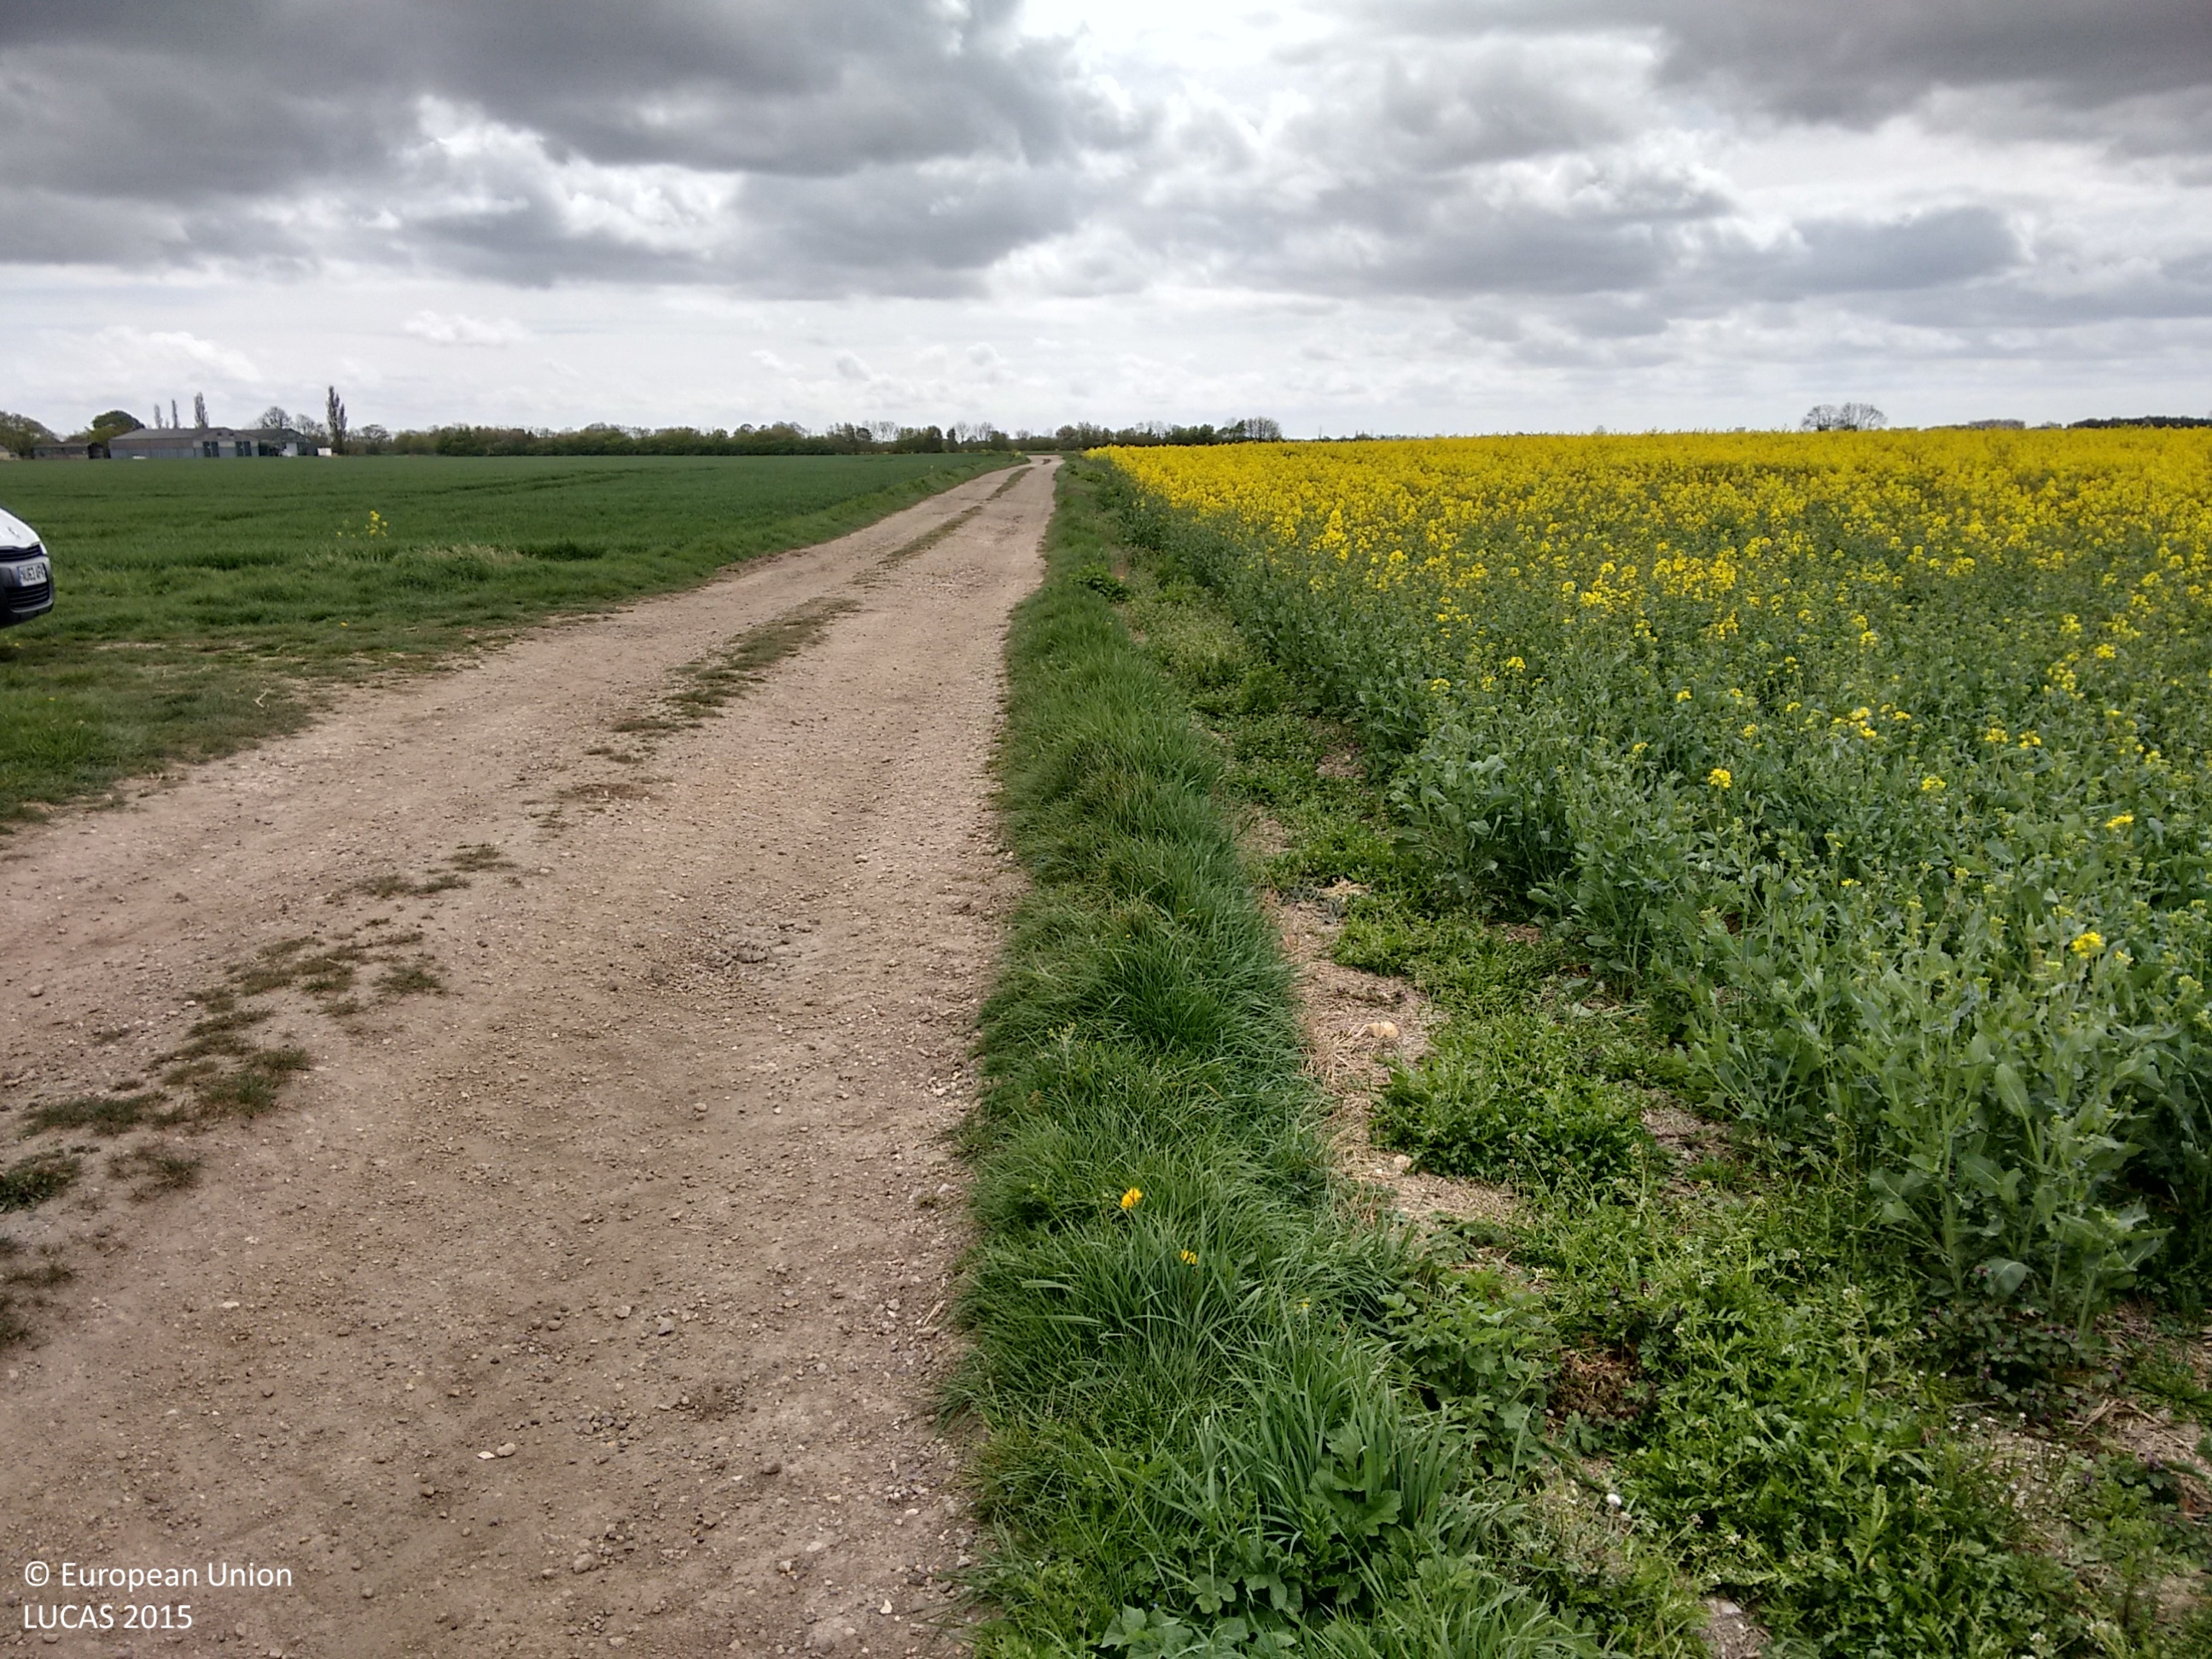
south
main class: Cropland
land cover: Rape and turnip rape
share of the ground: > 75 %
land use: Agriculture (excluding fallow land and kitchen gardens)
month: May
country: GB
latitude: 53.0632
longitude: 0.0449
